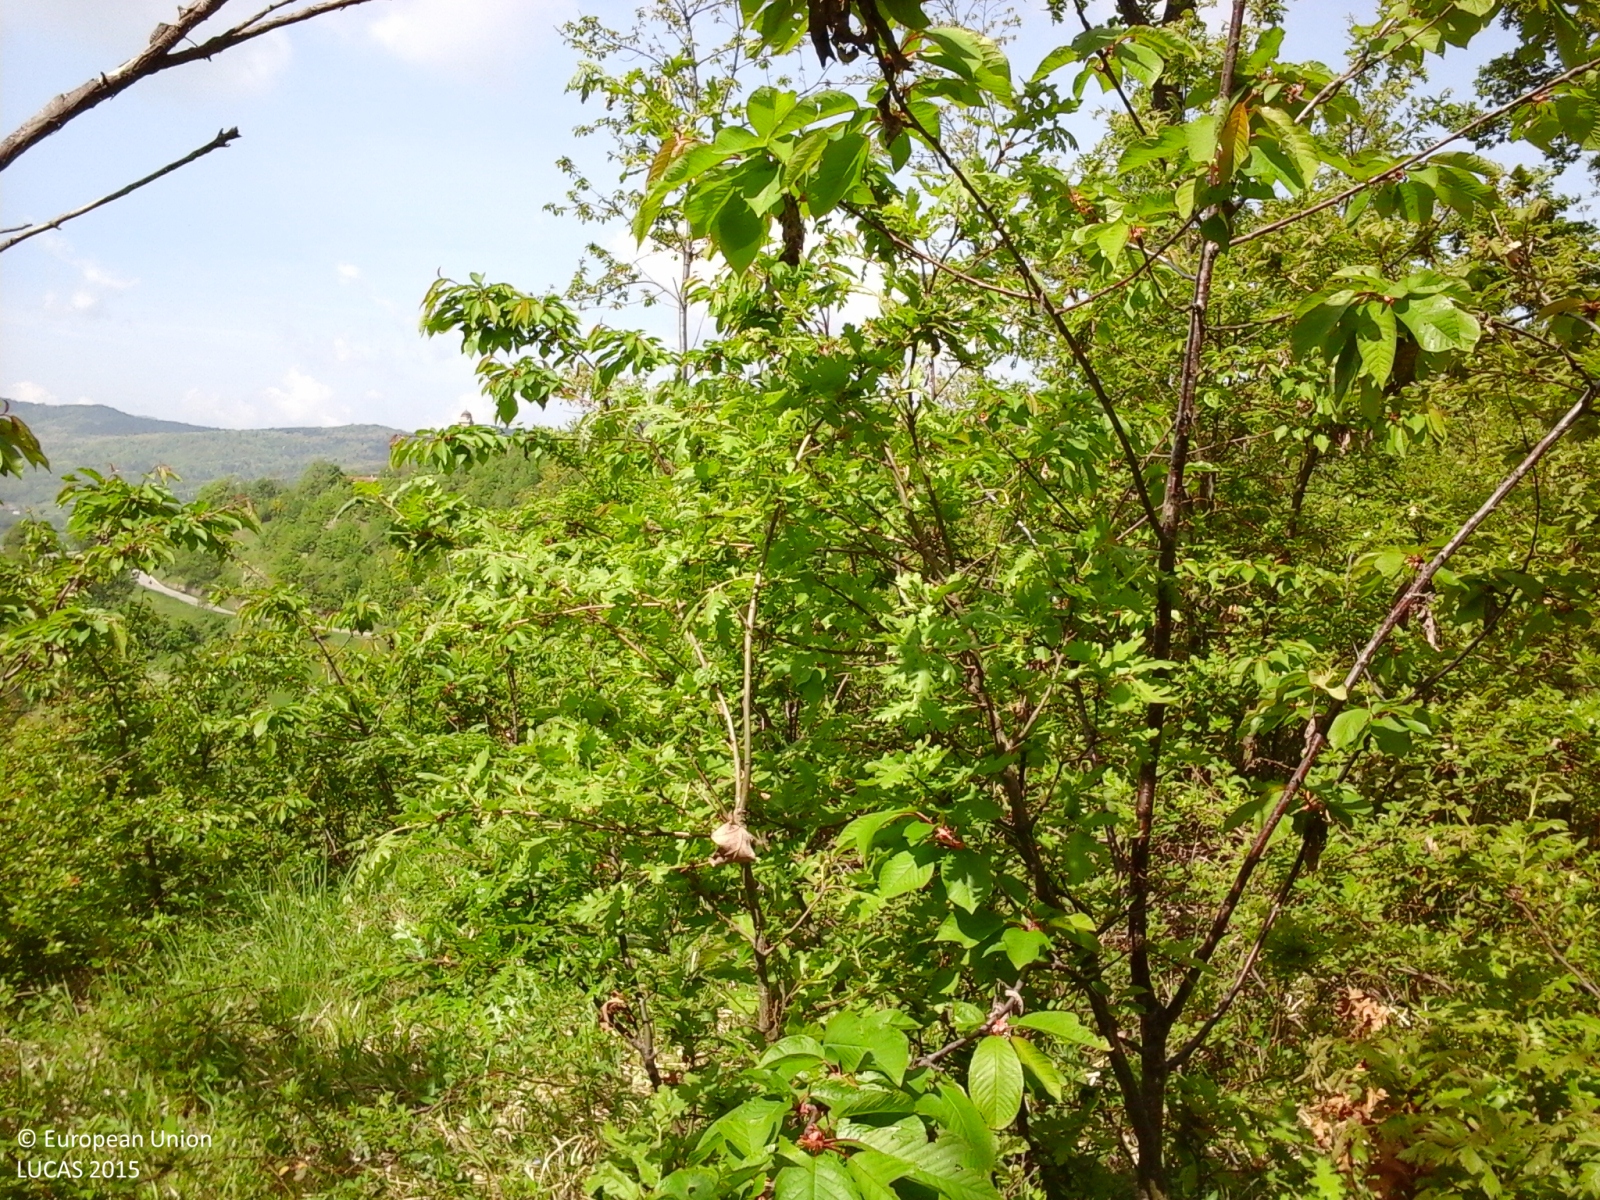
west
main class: Woodland
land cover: Broadleaved woodland
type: thermophilous deciduous forest
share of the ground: > 75 %
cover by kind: broadleaved forest trees 70 %, shrubs 20 %, herbaceous plants 10 %
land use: Forestry
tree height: > 5 m
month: May
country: IT
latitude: 44.7283
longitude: 9.5590
